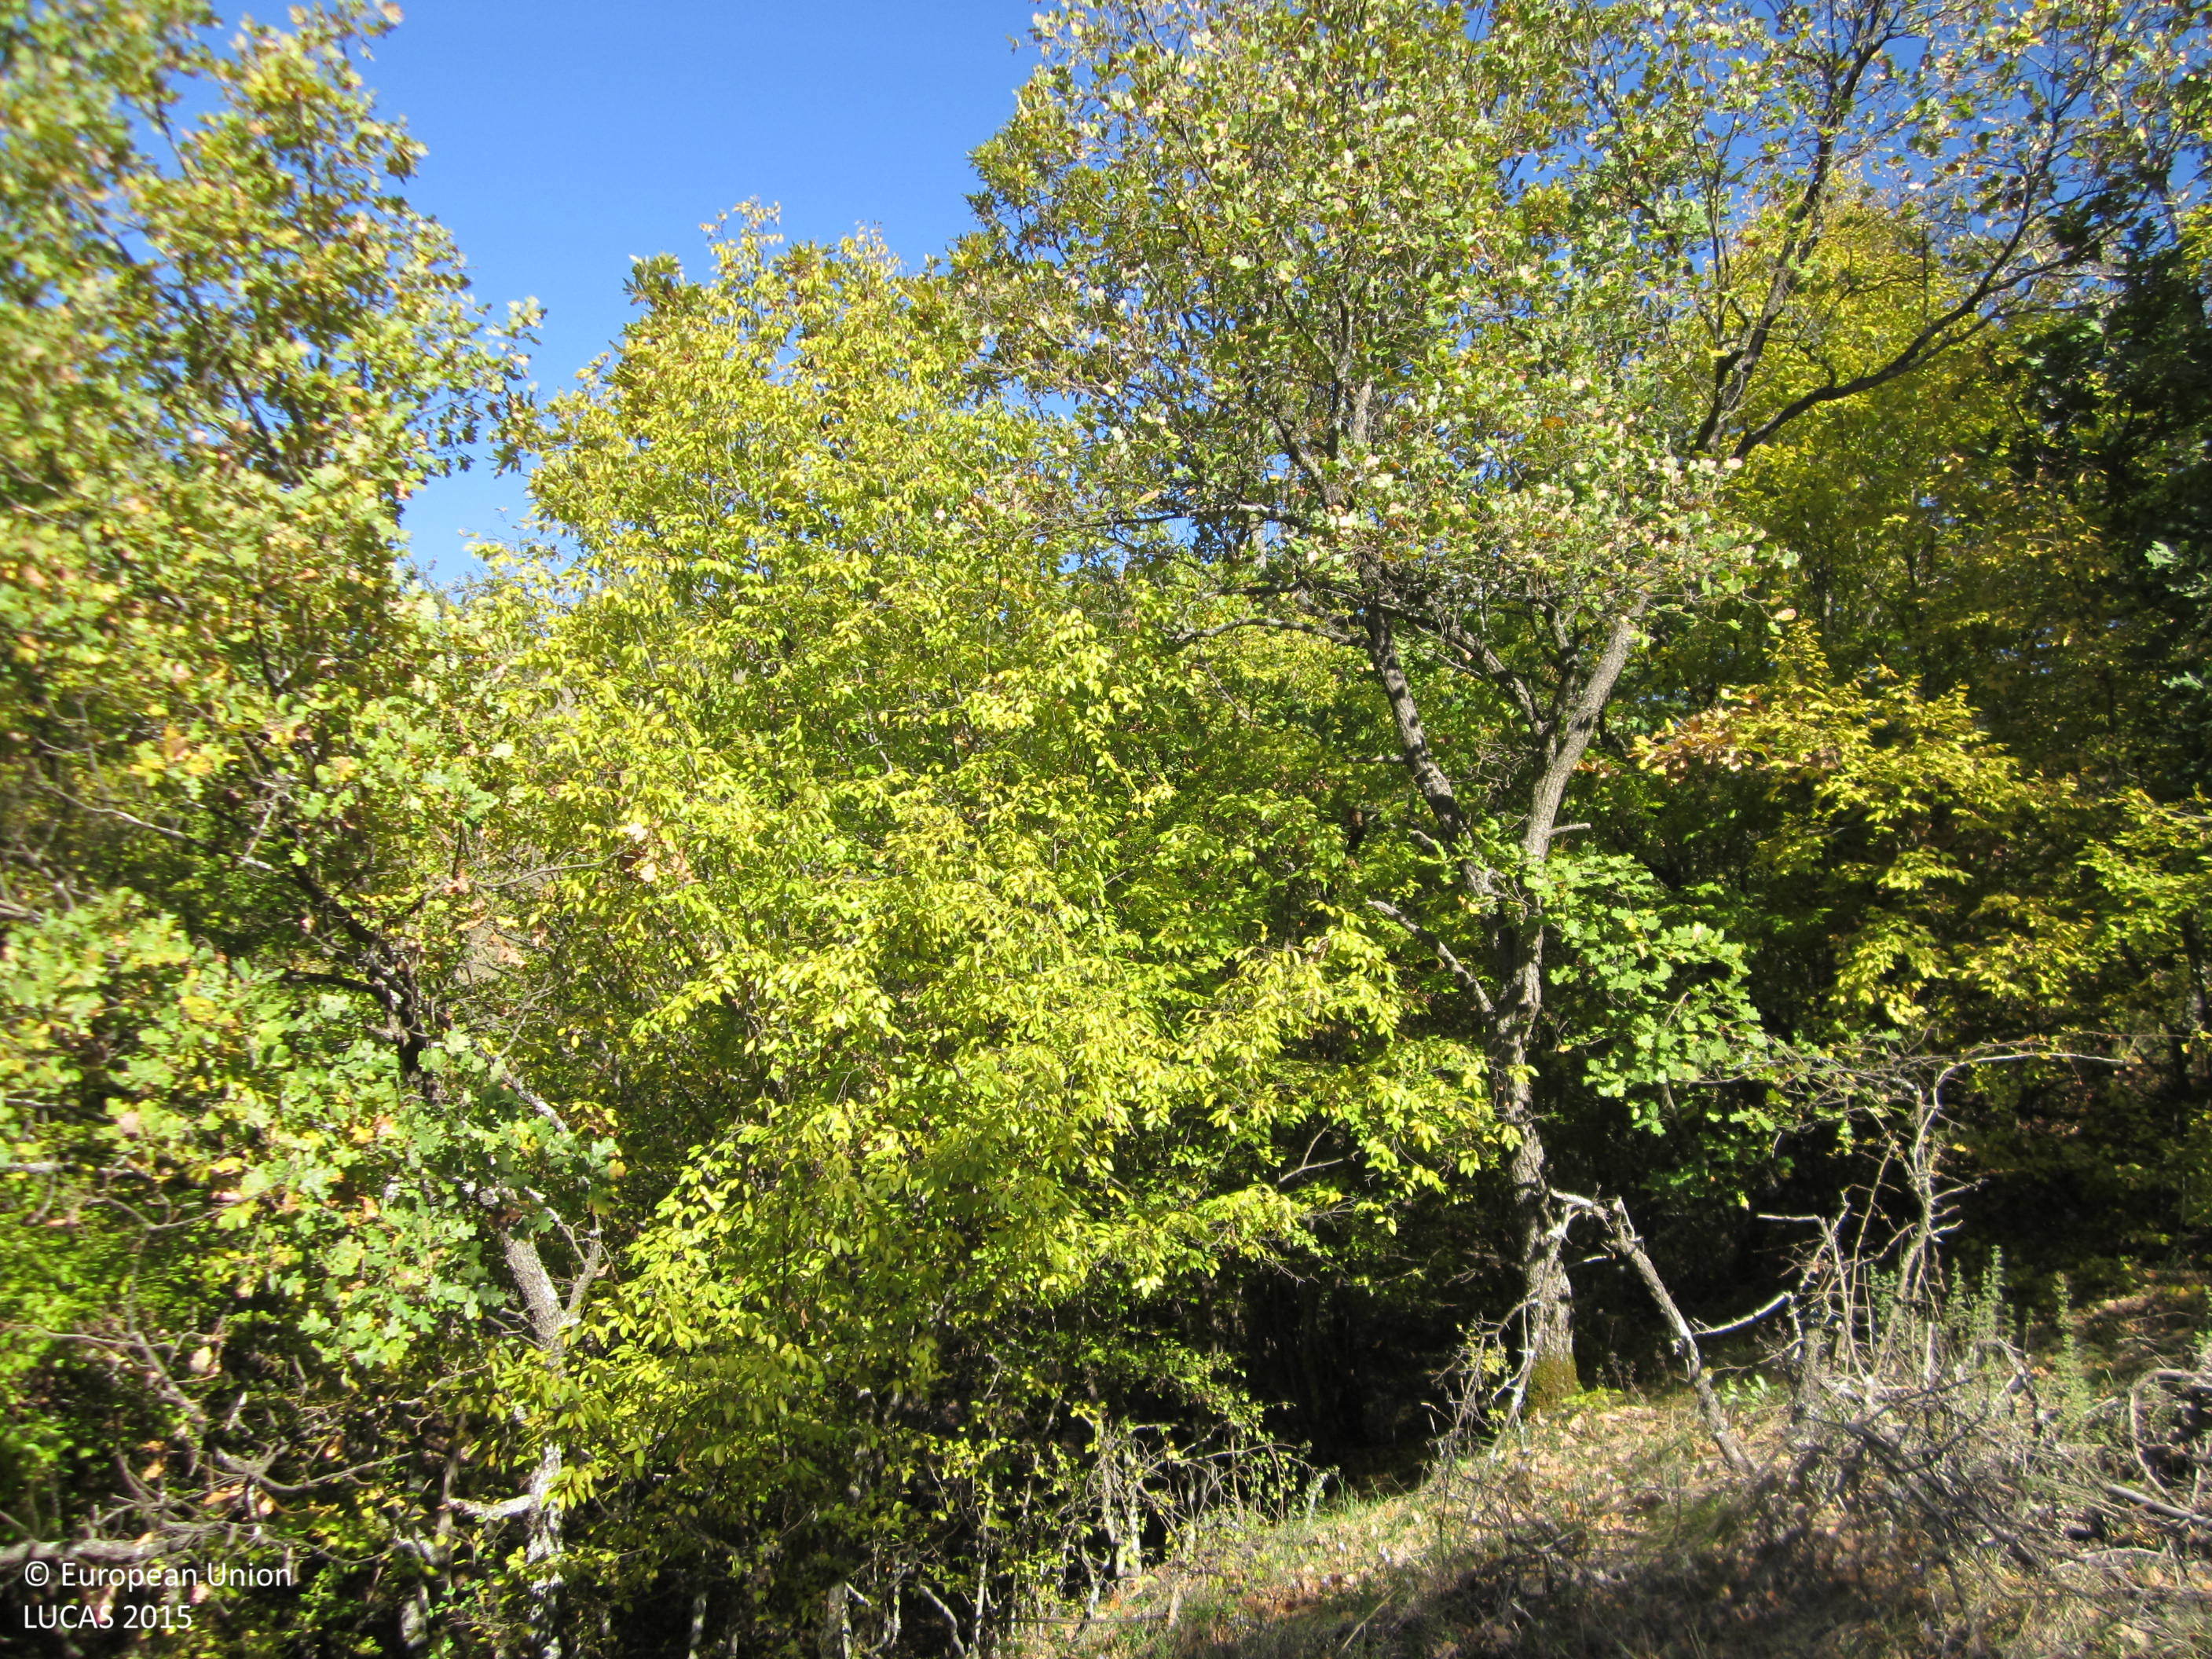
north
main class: Woodland
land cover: Broadleaved woodland
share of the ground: > 75 %
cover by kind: broadleaved forest trees 80 %, herbaceous plants 15 %, shrubs 5 %
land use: Forestry
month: November
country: BG
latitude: 41.4589
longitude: 25.8062
